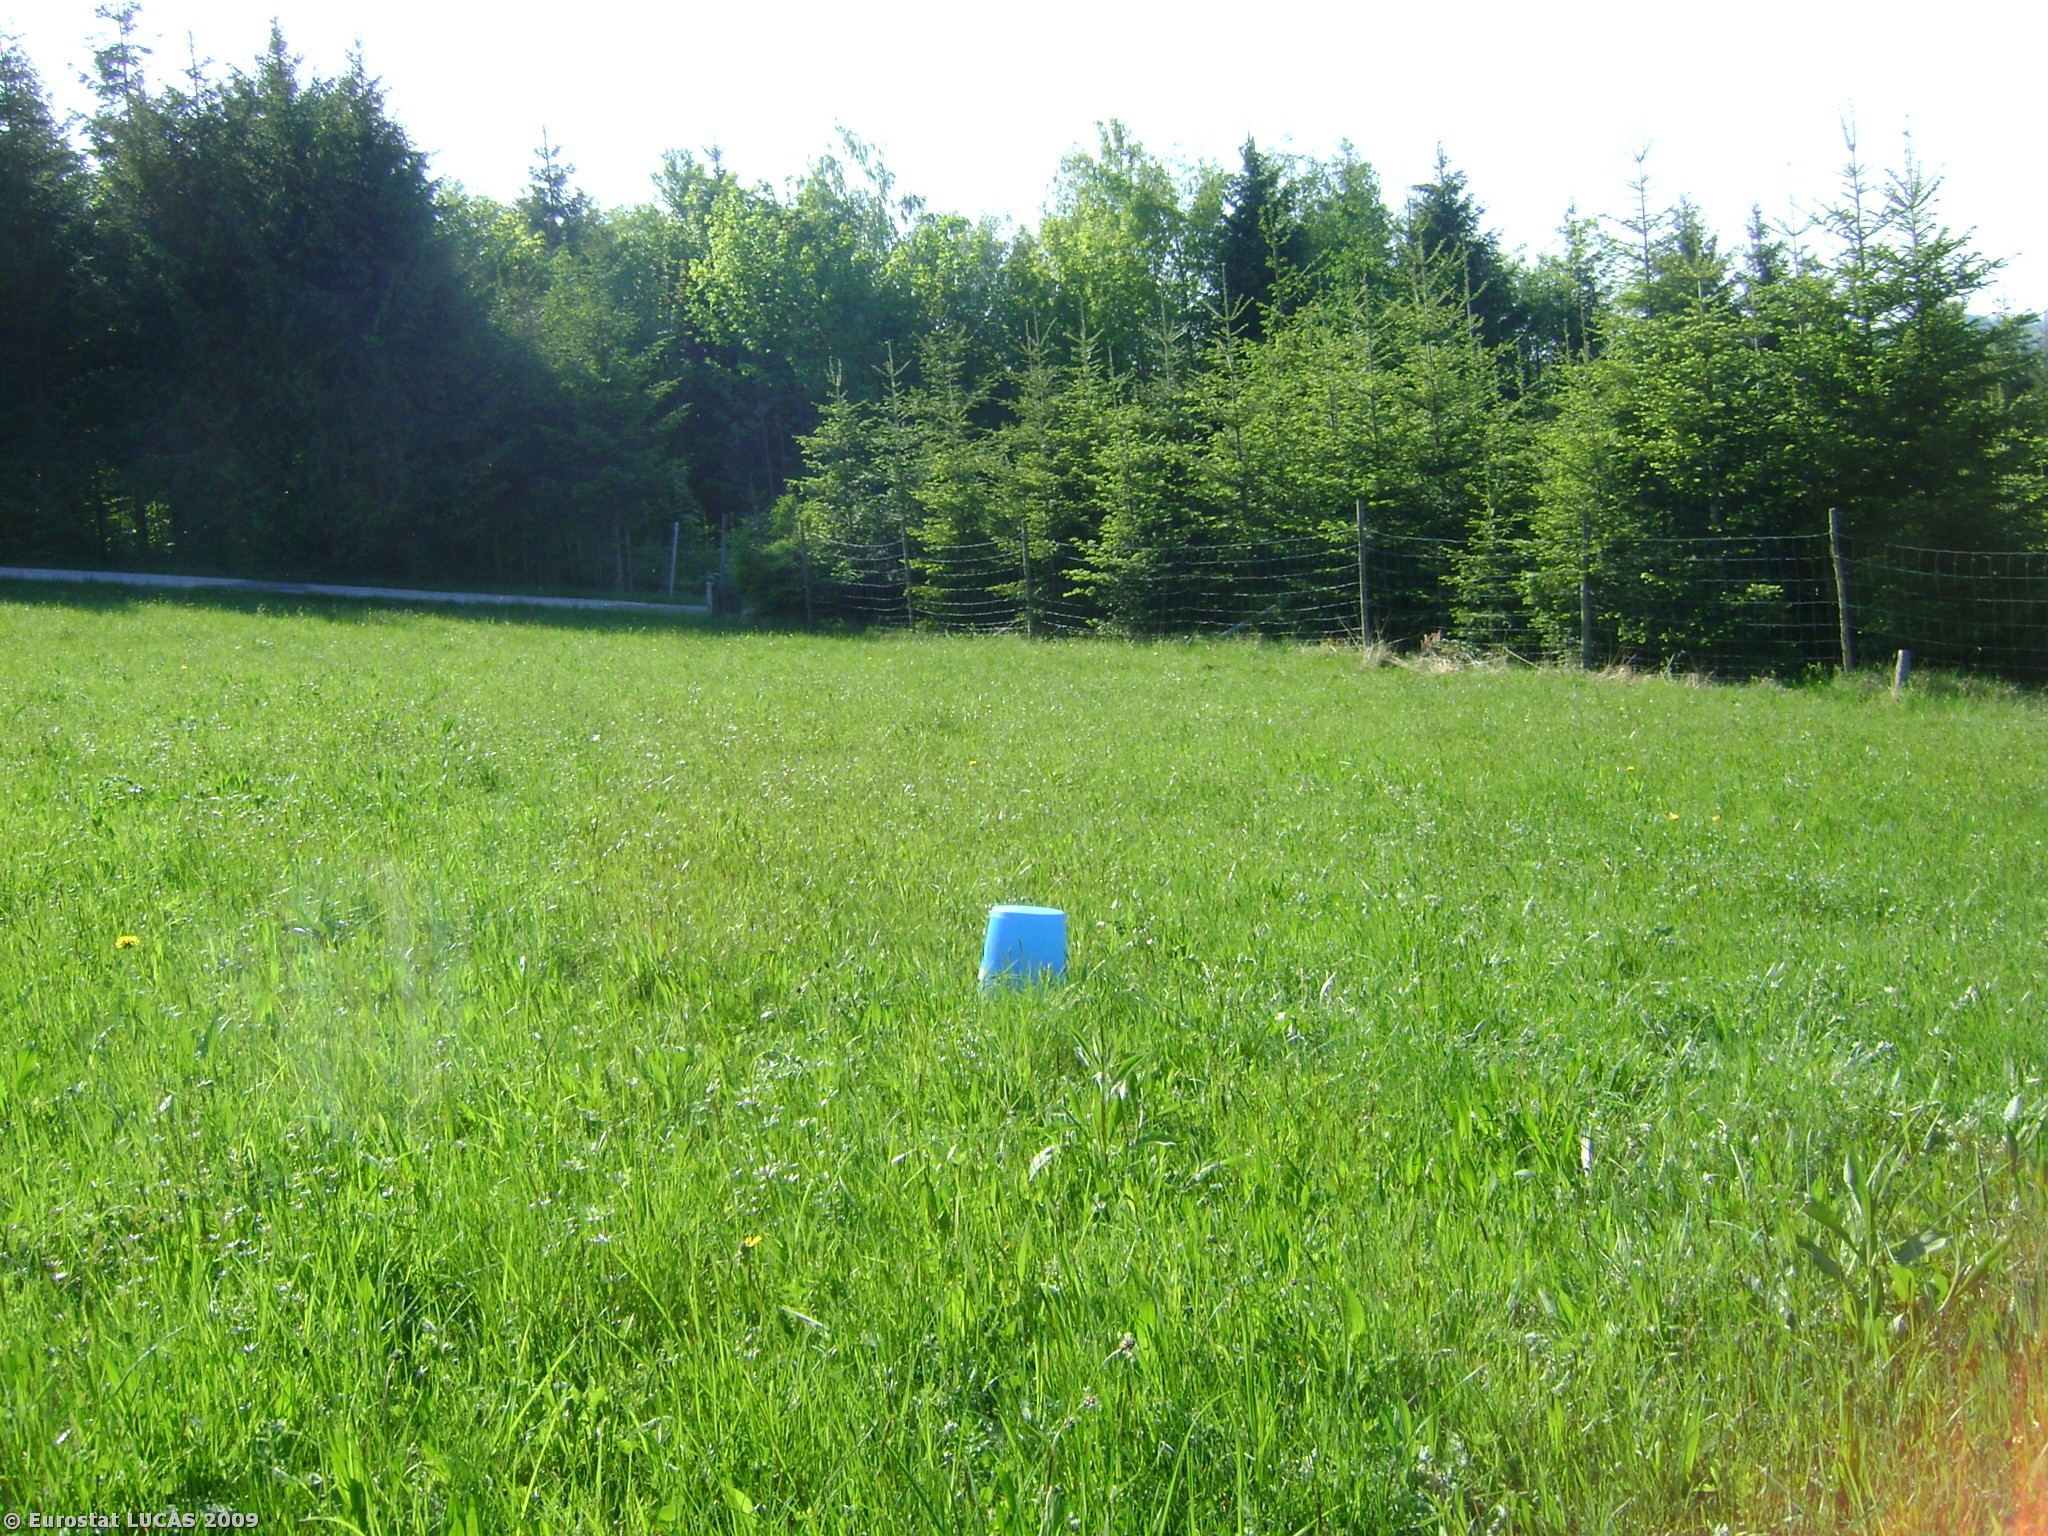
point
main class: Grassland
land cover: Grassland without tree/shrub cover
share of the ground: > 75 %
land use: Agriculture (excluding fallow land and kitchen gardens)
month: May
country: AT
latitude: 47.8336
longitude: 13.2452
